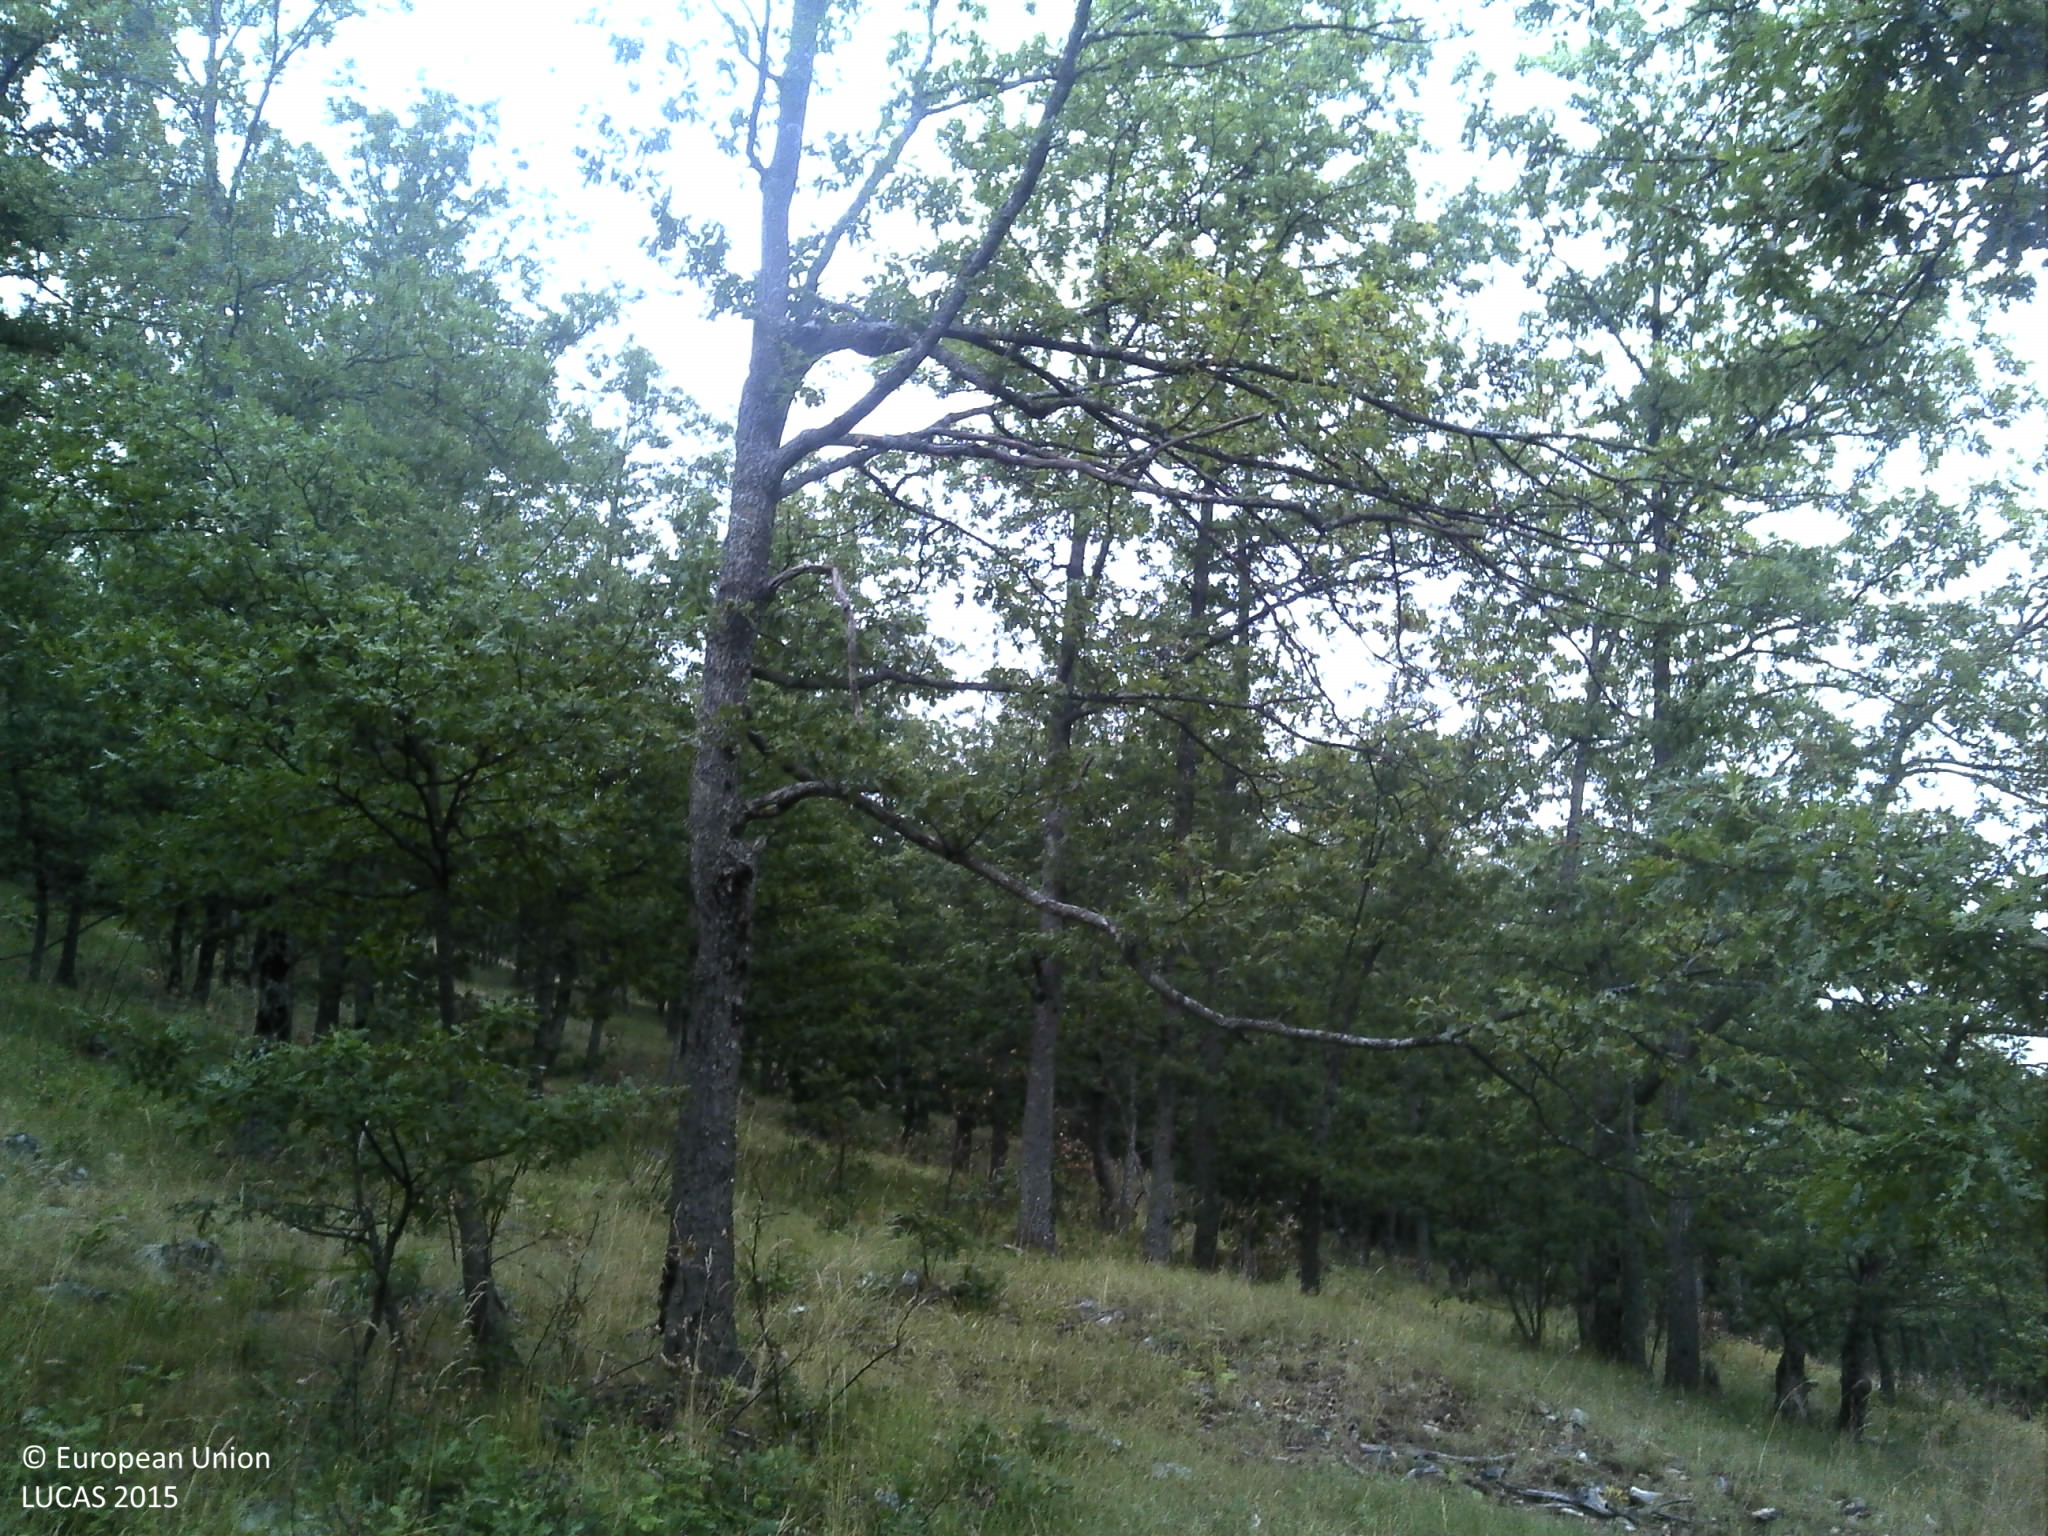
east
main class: Woodland
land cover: Broadleaved woodland
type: beech forest
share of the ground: 50 - 75 %
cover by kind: broadleaved forest trees 50 %, herbaceous plants 40 %, shrubs 10 %
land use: Semi-natural and natural areas not in use
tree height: > 5 m
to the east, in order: Broadleaved woodland; Shrubland with sparse tree cover; Broadleaved woodland; Inland fresh running water; Broadleaved woodland
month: July
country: HR
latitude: 44.4265
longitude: 16.0608
